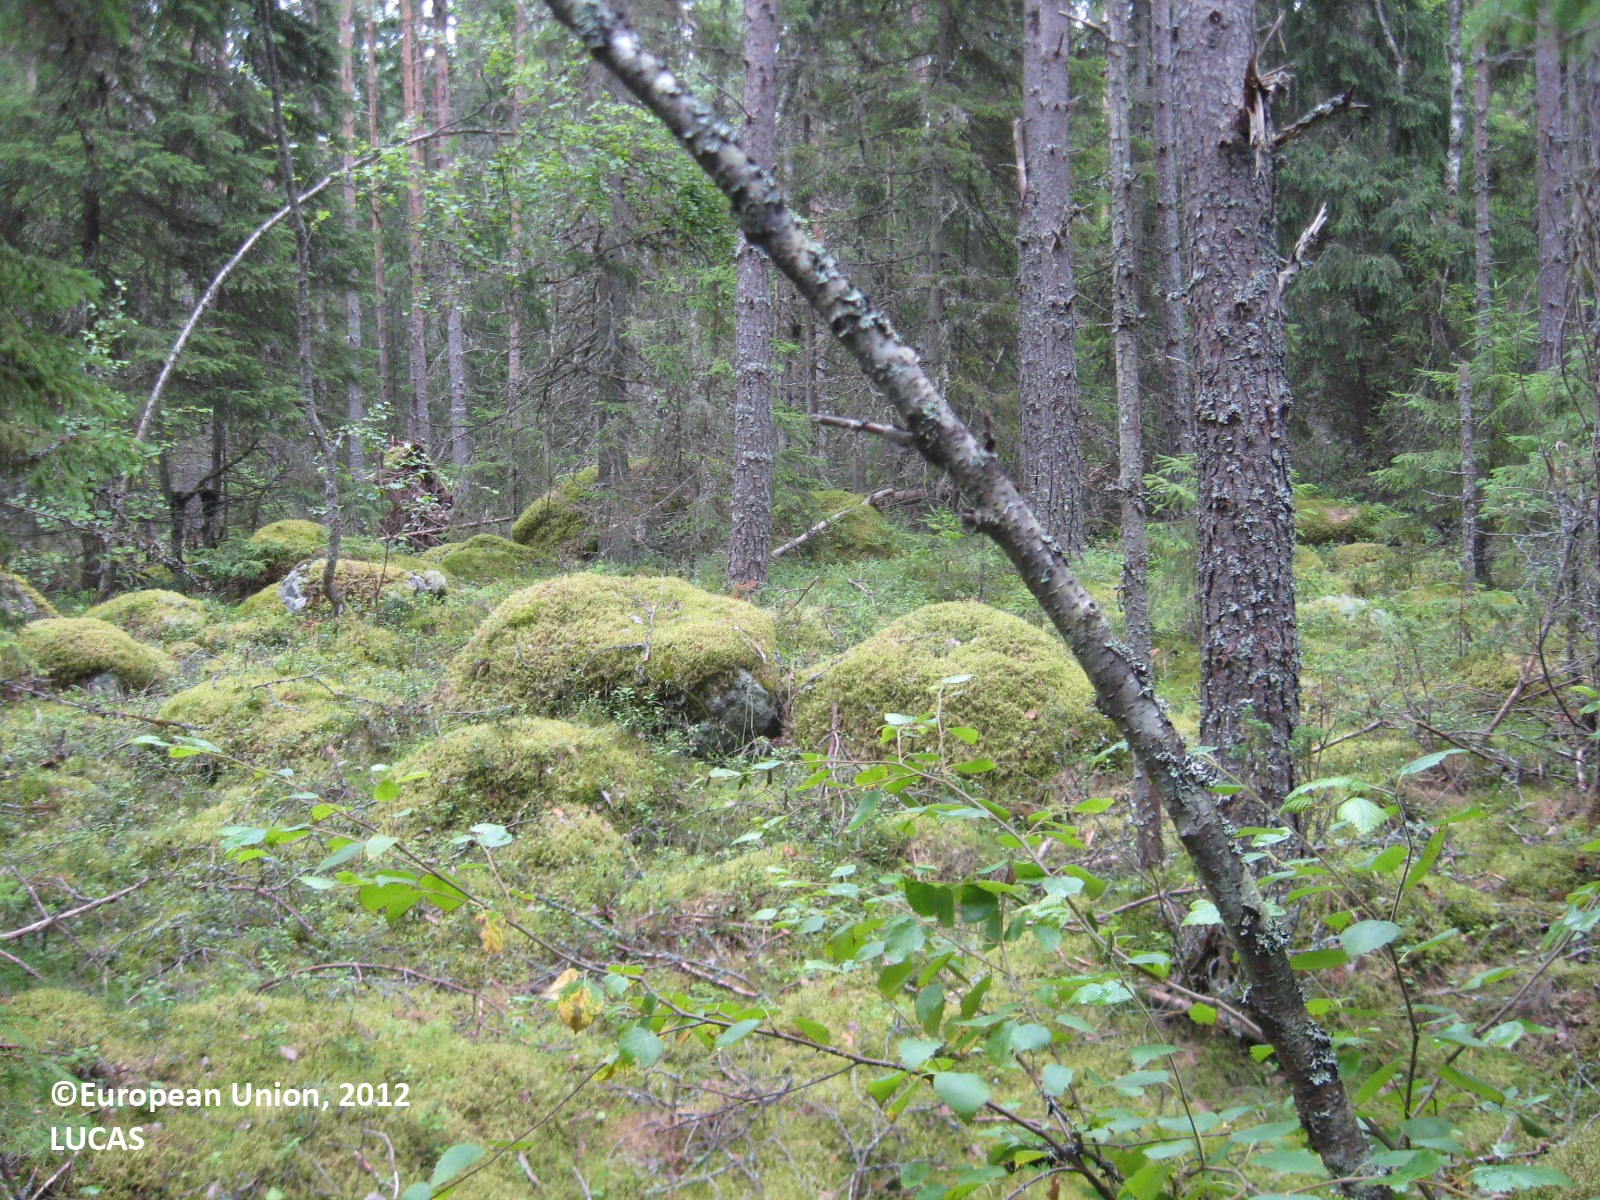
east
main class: Woodland
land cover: Other coniferous woodland
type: boreal forest
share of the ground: > 75 %
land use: Forestry
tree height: > 5 m
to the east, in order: Other coniferous woodland; Ditches and canals; Spruce dominated coniferous woodland
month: July
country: FI
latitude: 61.8741
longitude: 21.5528
